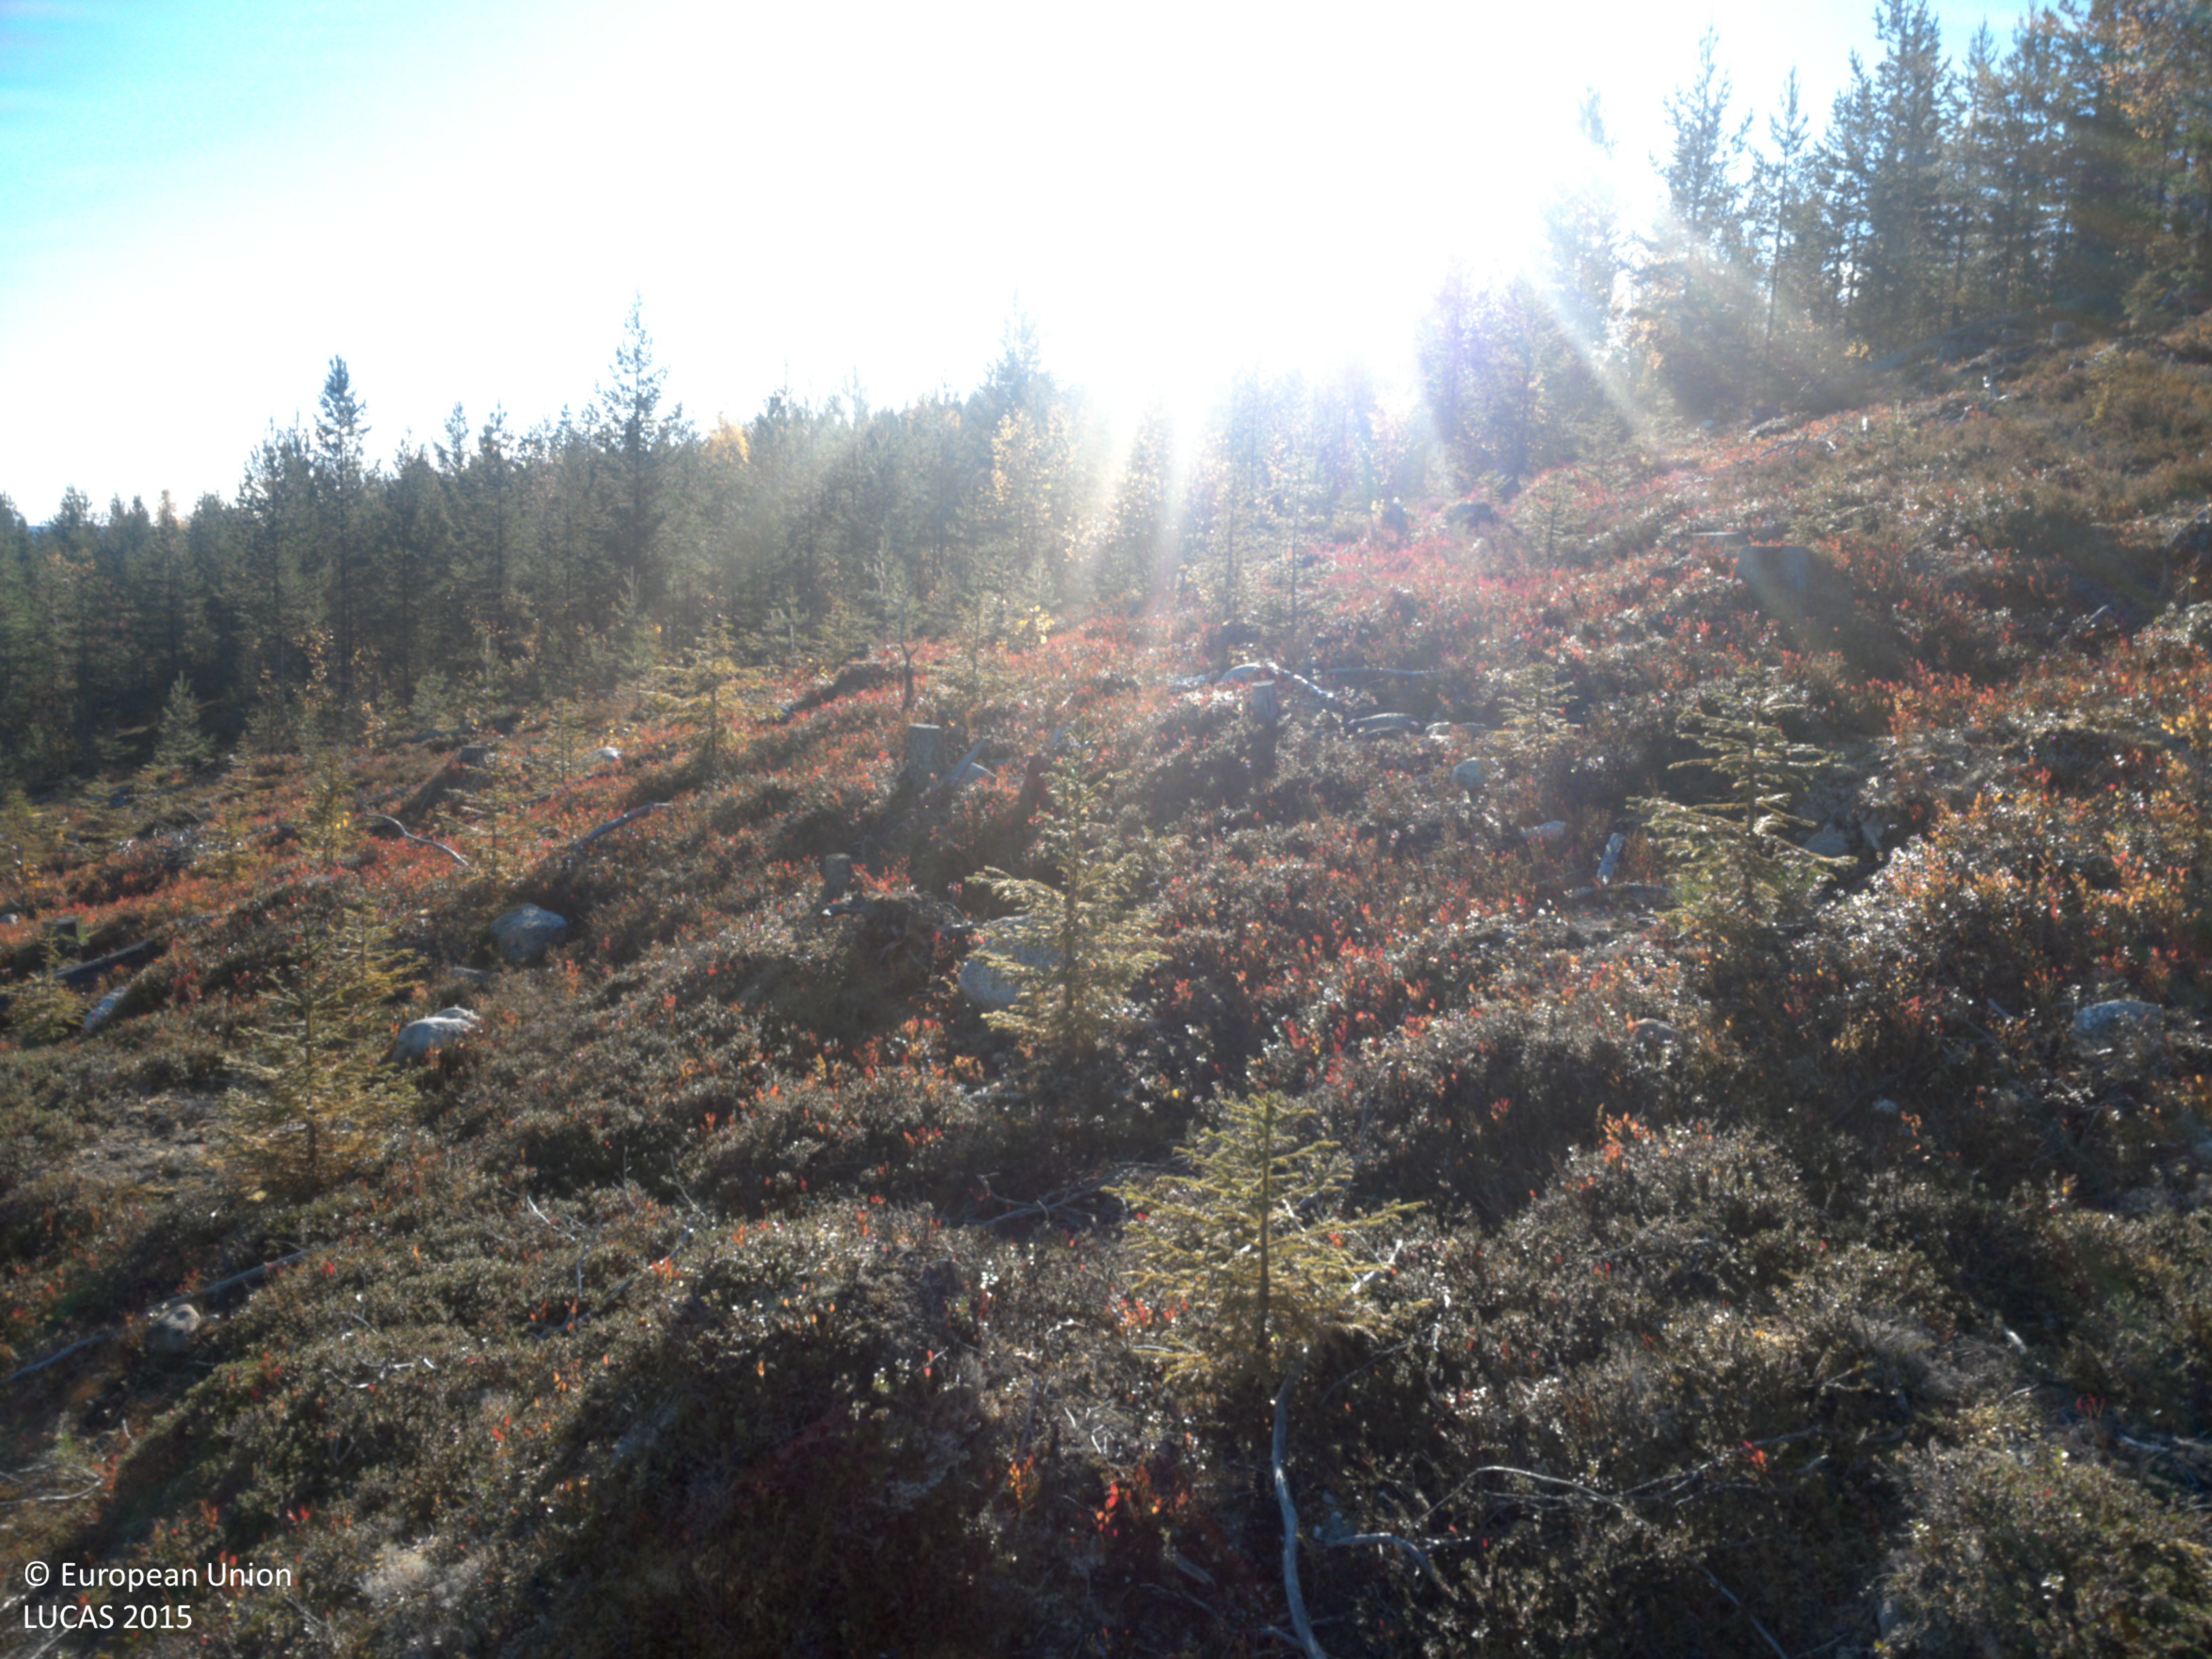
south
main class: Shrubland
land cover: Shrubland with sparse tree cover
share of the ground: > 75 %
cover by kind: shrubs 80 %, lichens and mosses 10 %, coniferous forest trees 5 %, herbaceous plants 5 %
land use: Forestry
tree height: < 5 m
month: October
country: SE
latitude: 64.7689
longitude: 18.5235
